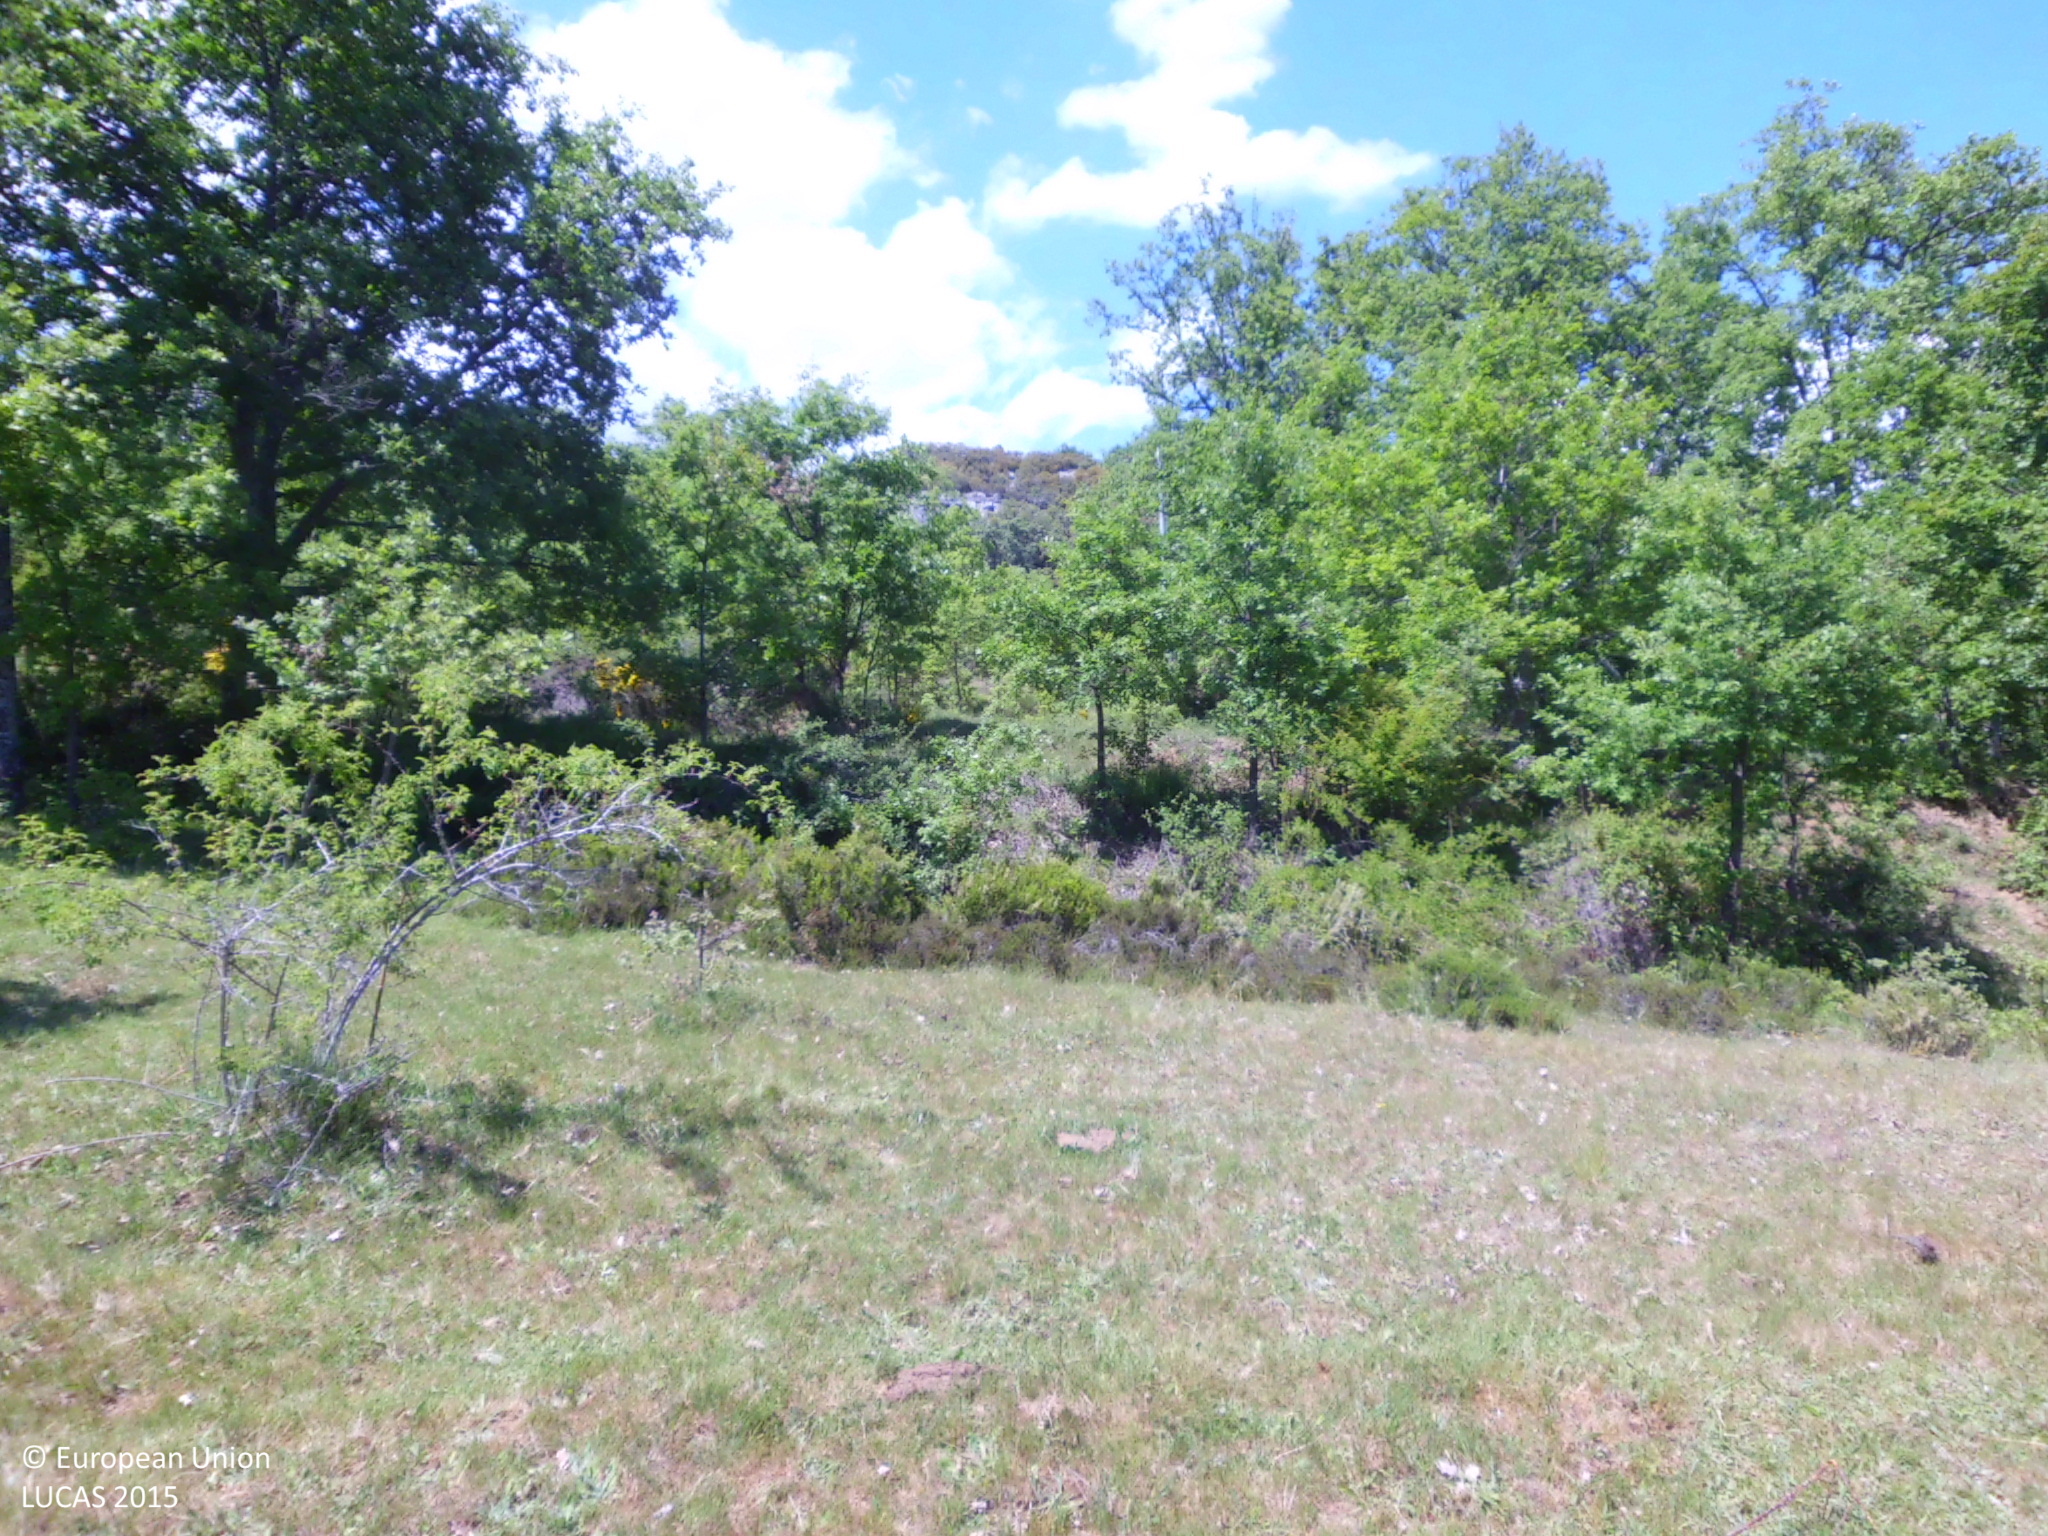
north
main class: Grassland
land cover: Grassland with sparse tree/shrub cover
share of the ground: > 75 %
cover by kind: herbaceous plants 90 %, broadleaved forest trees 5 %, shrubs 5 %
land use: Agriculture (excluding fallow land and kitchen gardens)
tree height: < 5 m
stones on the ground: > 50 %
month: May
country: ES
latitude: 42.8576
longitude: -5.4323
